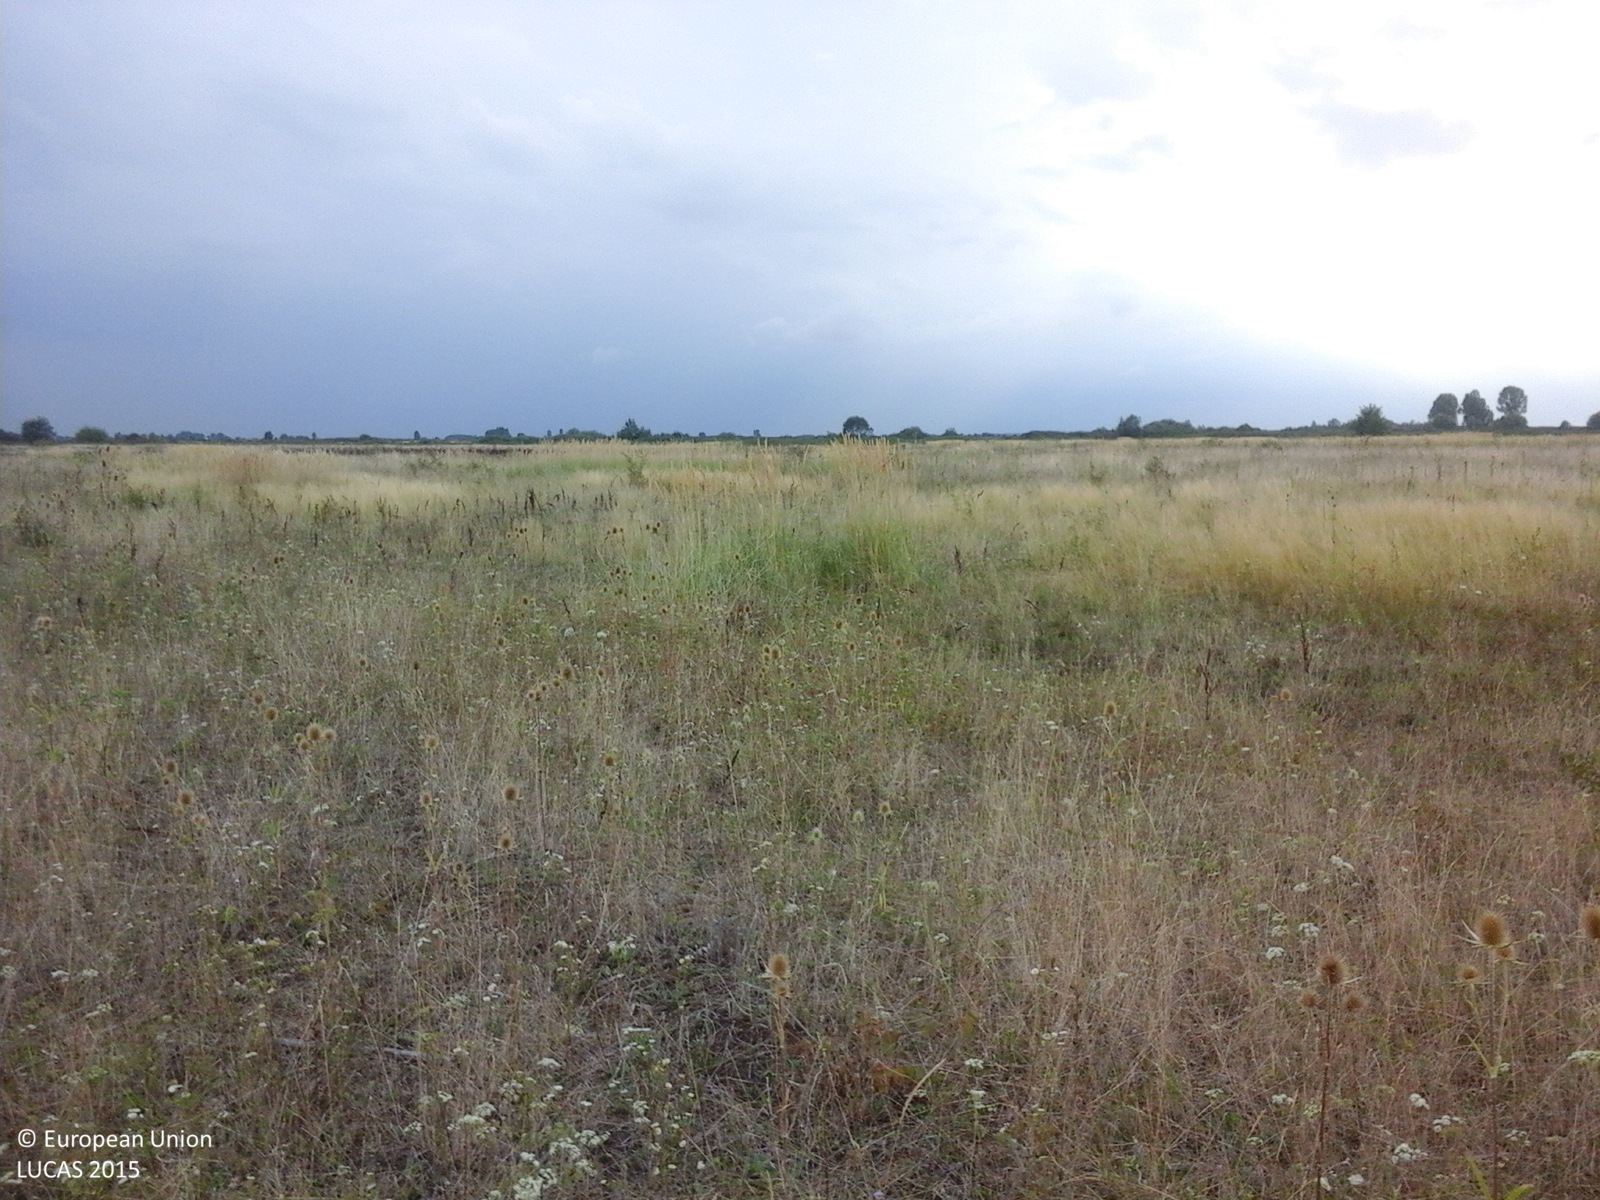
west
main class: Grassland
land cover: Grassland without tree/shrub cover
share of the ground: > 75 %
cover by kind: herbaceous plants 100 %
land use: Agriculture (excluding fallow land and kitchen gardens)
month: August
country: RO
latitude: 45.6772
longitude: 21.4716
